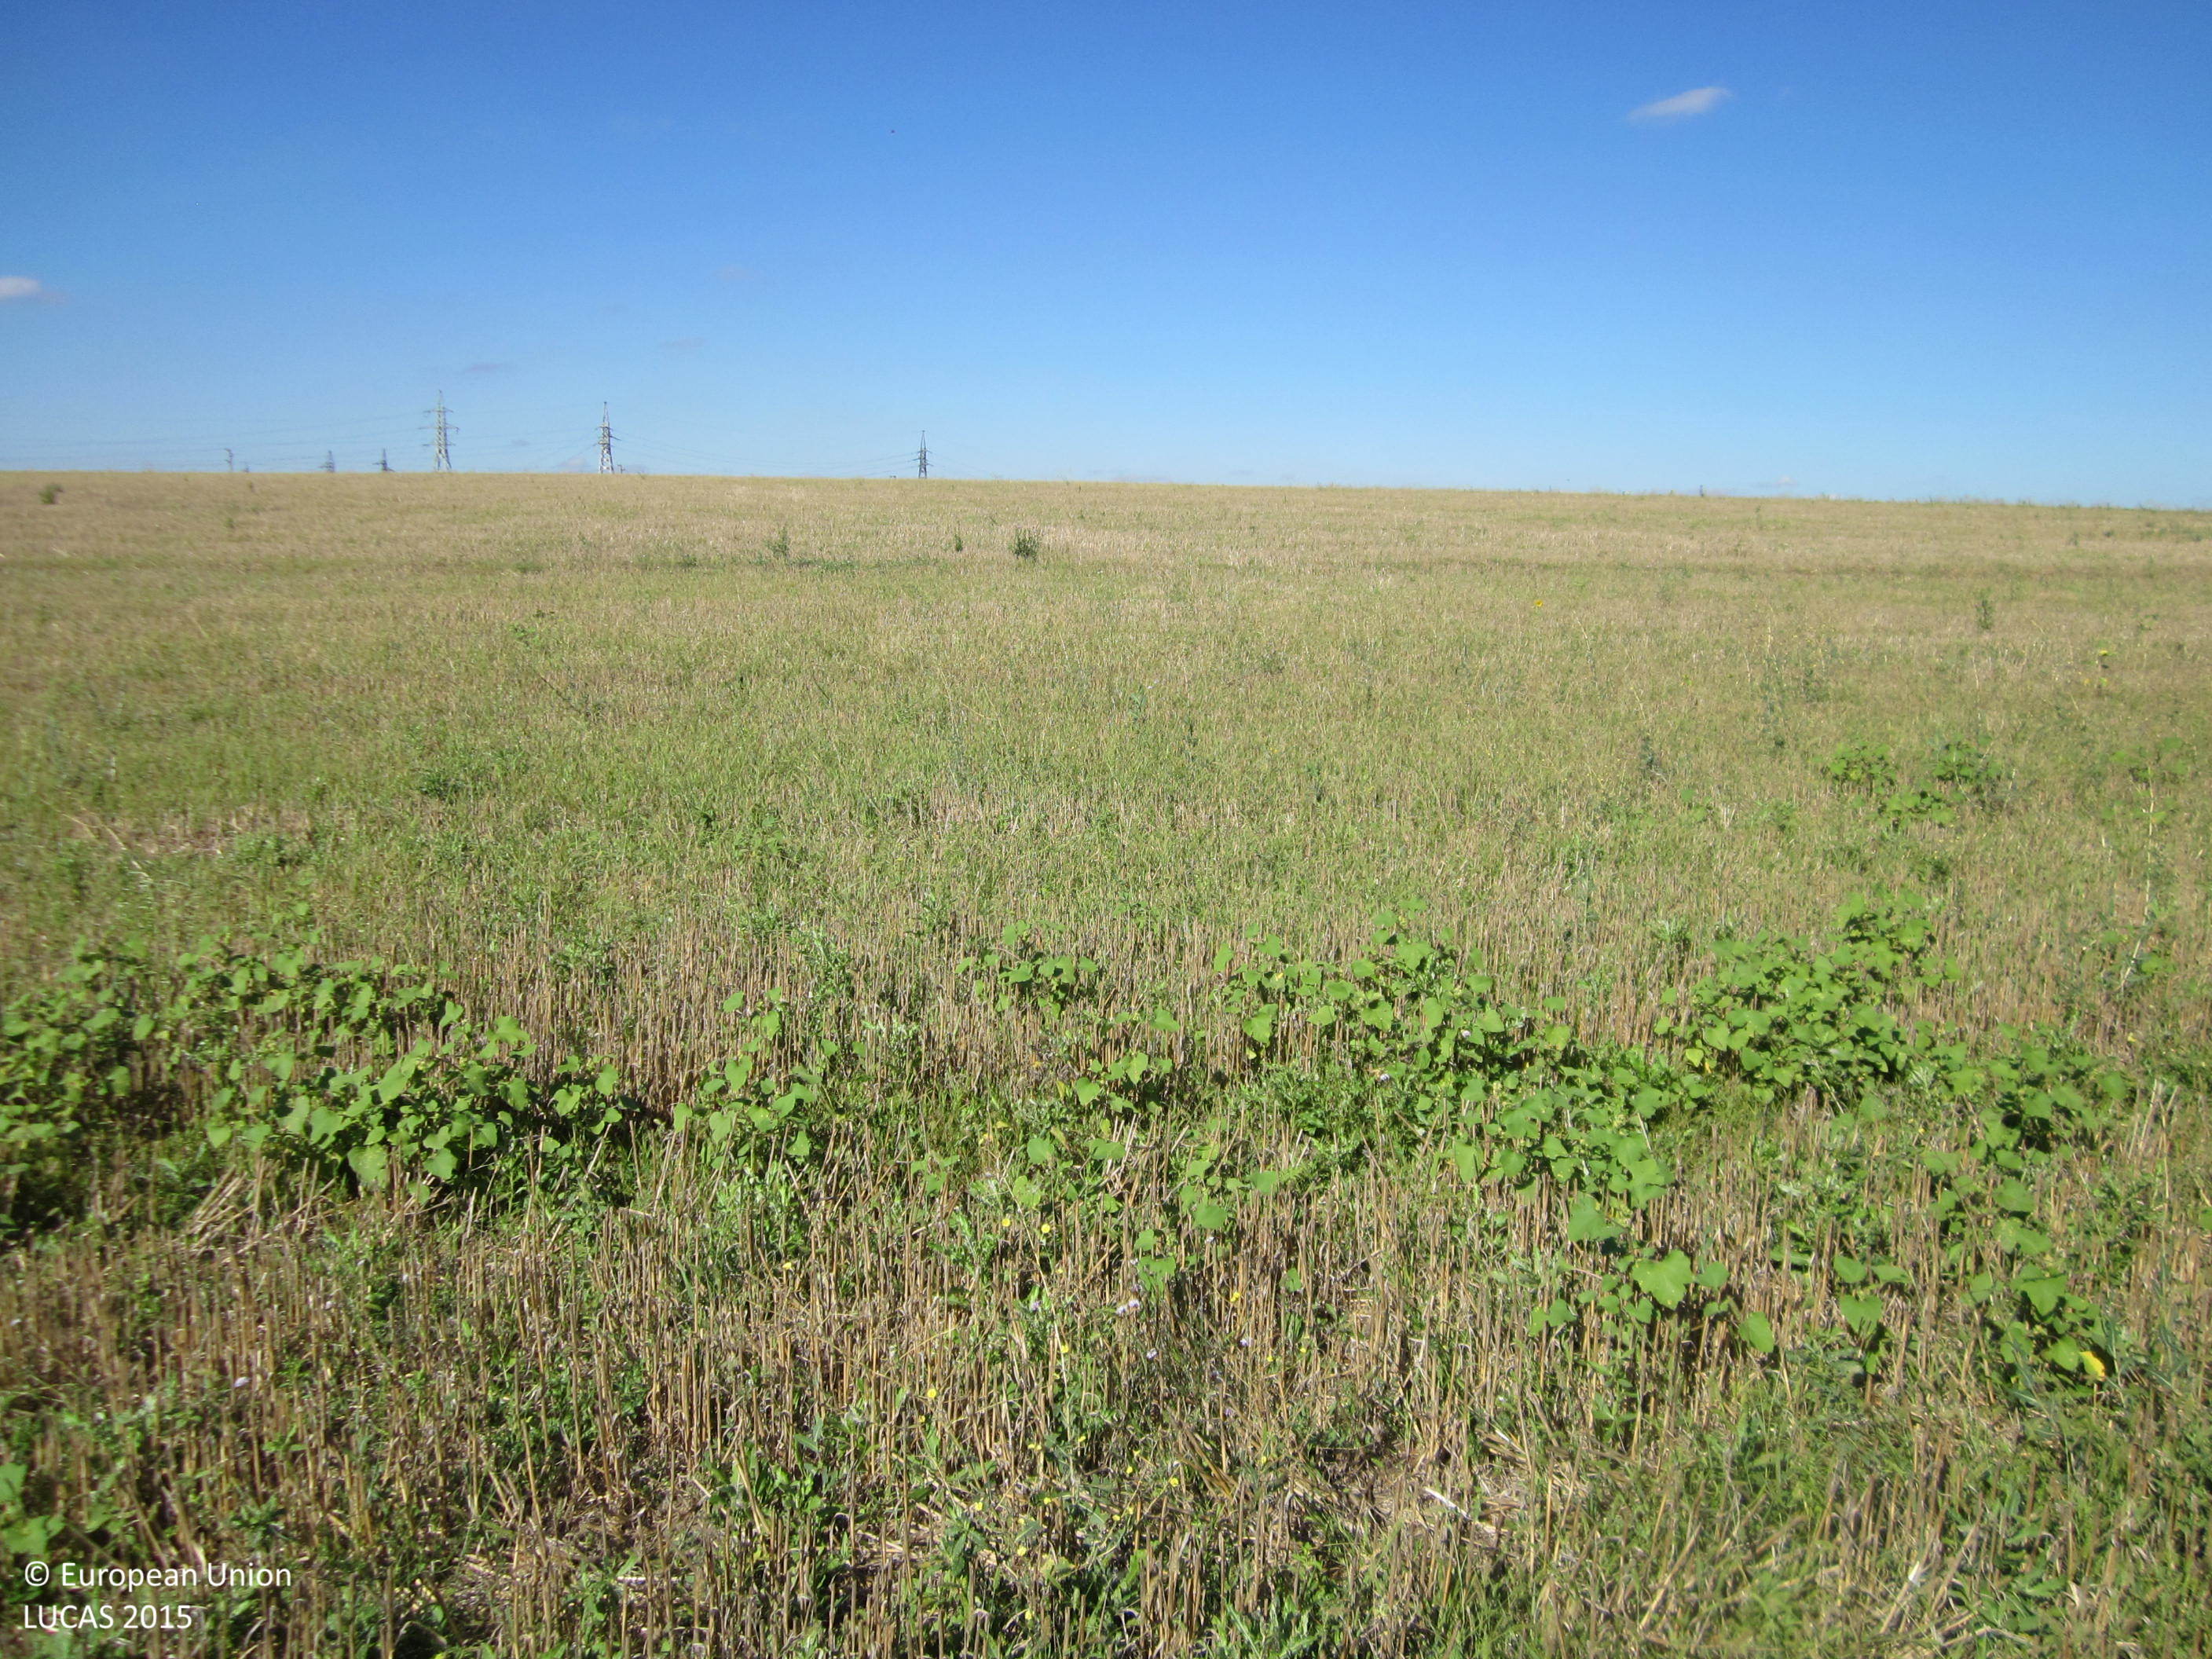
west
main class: Grassland
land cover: Grassland without tree/shrub cover
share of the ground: > 75 %
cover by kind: herbaceous plants 100 %
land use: Semi-natural and natural areas not in use
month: September
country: BG
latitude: 42.5837
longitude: 27.3315
